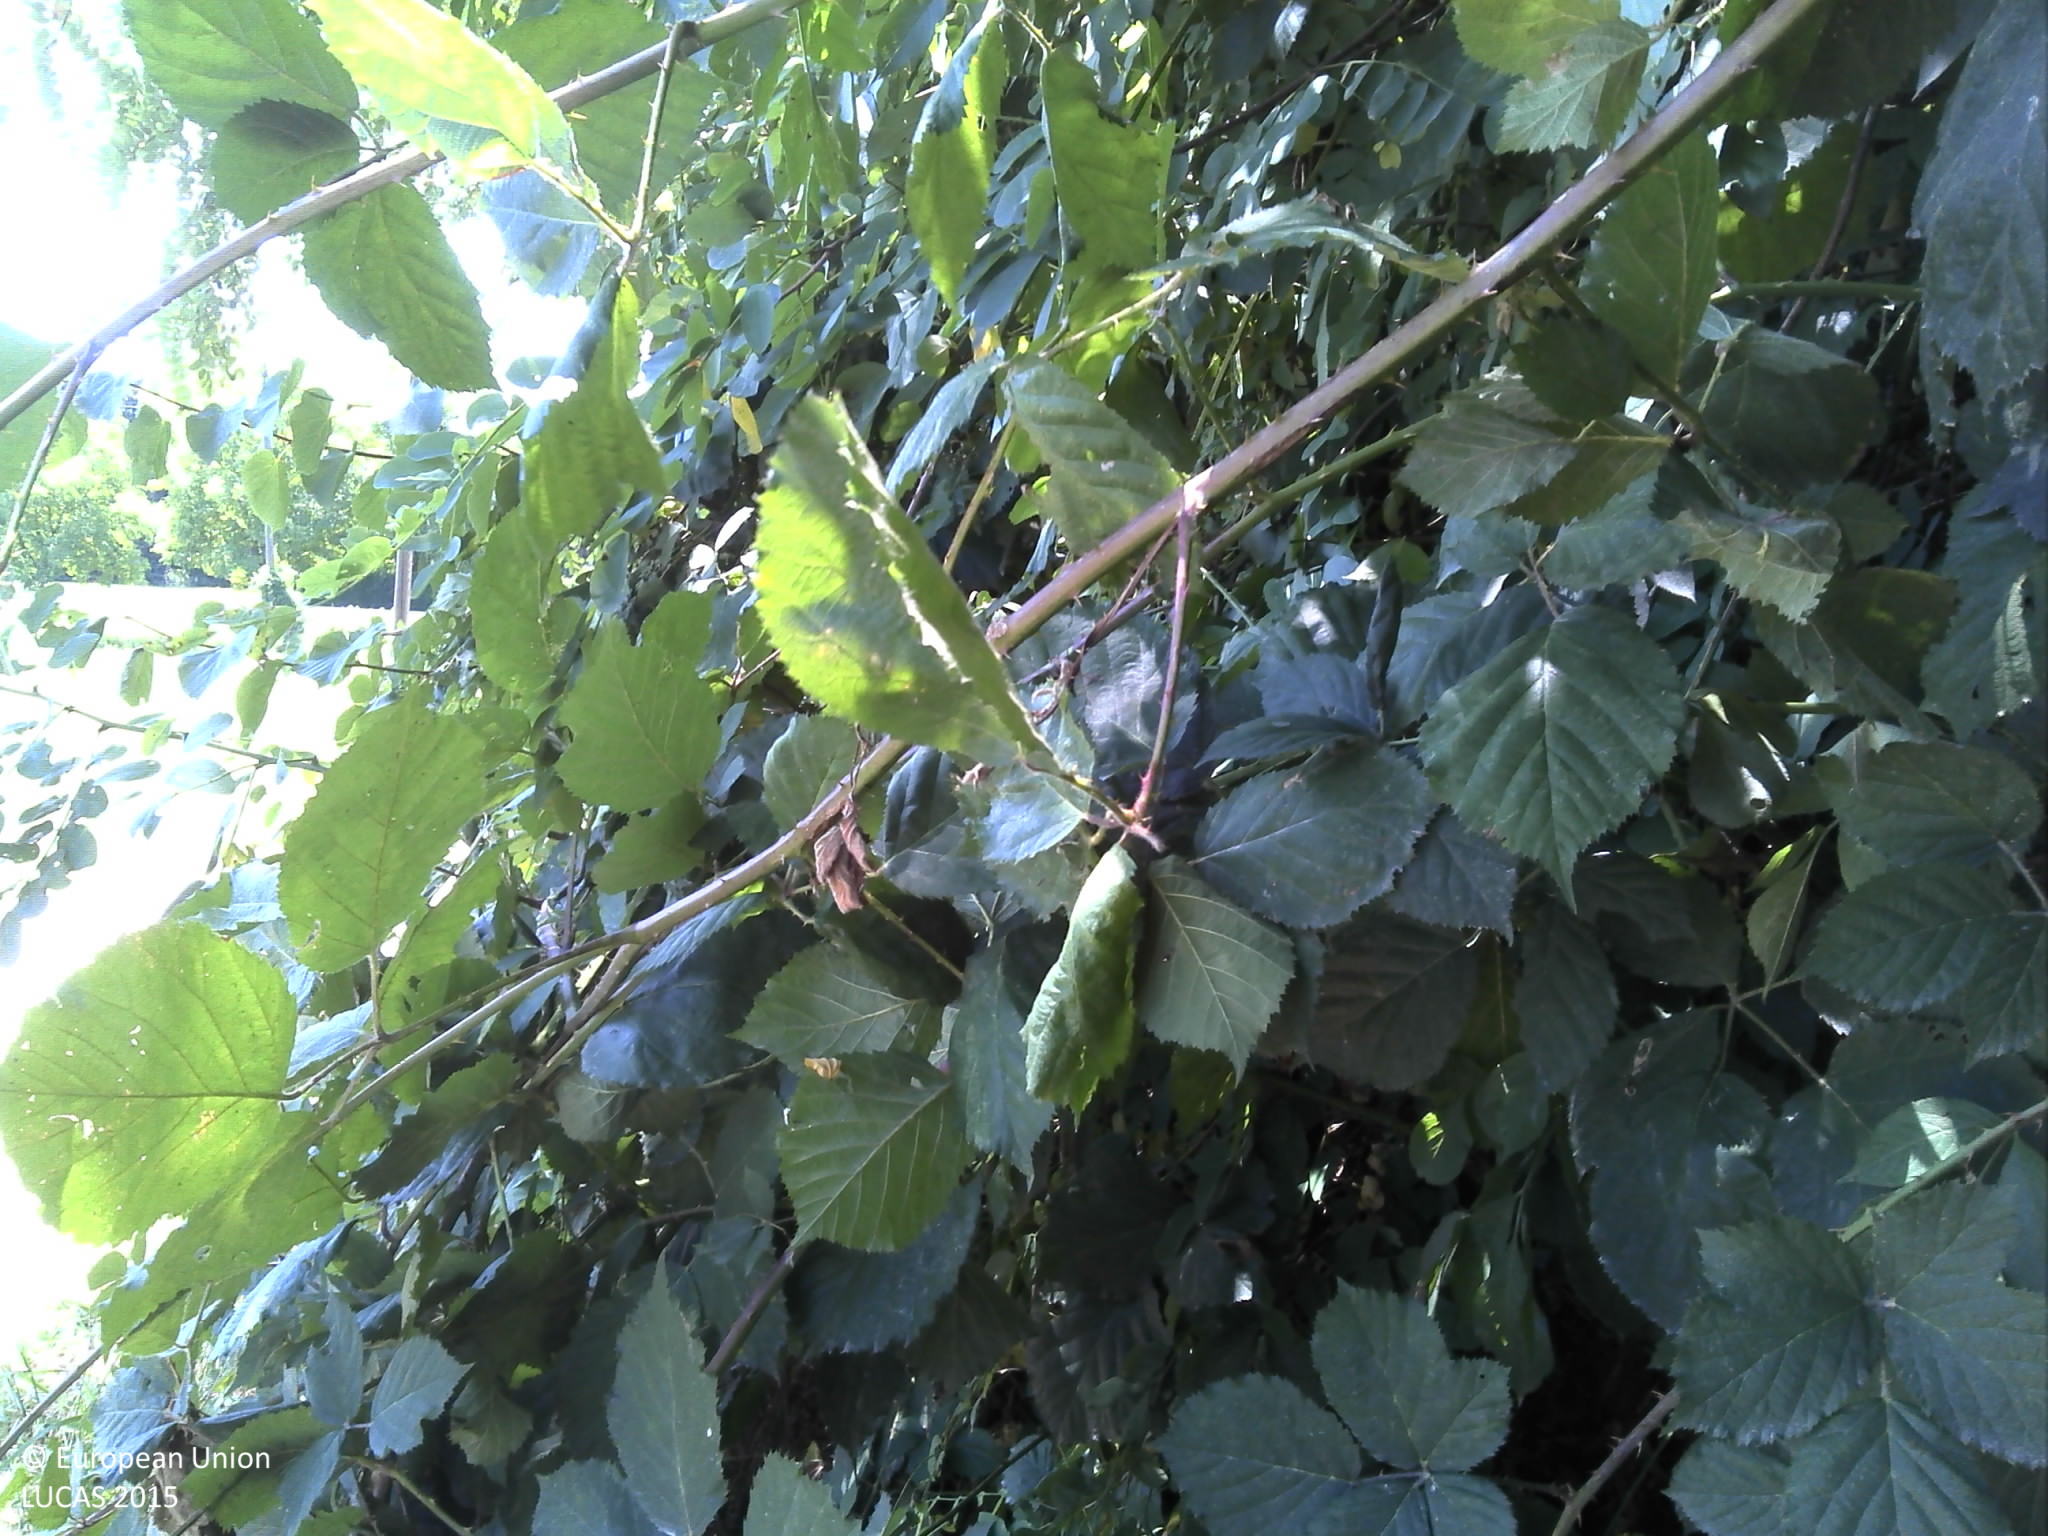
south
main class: Shrubland
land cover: Shrubland with sparse tree cover
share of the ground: > 75 %
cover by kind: shrubs 95 %, broadleaved forest trees 5 %
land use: Semi-natural and natural areas not in use
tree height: < 5 m
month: July
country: HR
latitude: 45.4632
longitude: 16.8413
